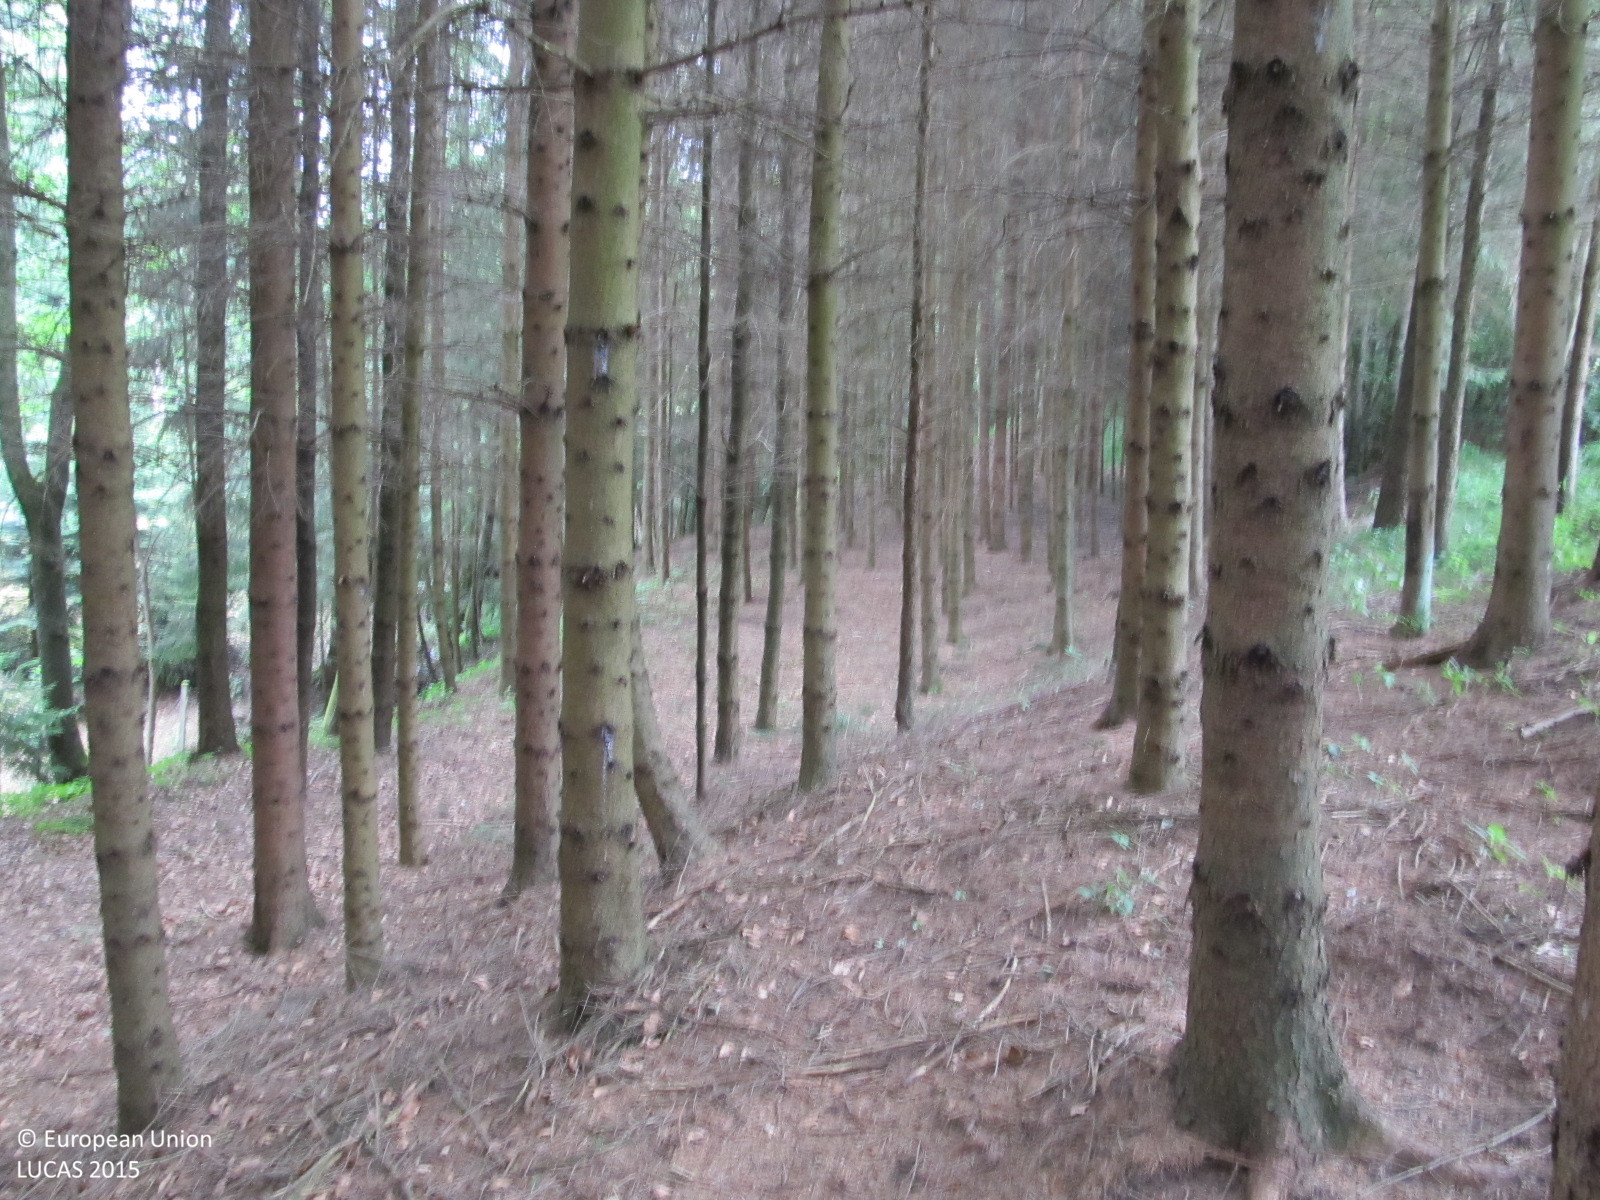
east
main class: Woodland
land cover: Spruce dominated coniferous woodland
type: hemiboreal forest and nemoral coniferous forest and mixed broadleaved-coniferous forest
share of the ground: > 75 %
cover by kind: coniferous forest trees 80 %, unconsolidated bare surface 20 %
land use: Forestry
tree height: > 5 m
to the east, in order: Spruce dominated coniferous woodland; Broadleaved woodland; Rivers and streams; Broadleaved woodland; Rivers and streams; Fences; Other coniferous woodland; Grass margins; Paved roads, cycling and walking lanes; Broadleaved woodland; Tracks; Broadleaved woodland
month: July
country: AT
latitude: 48.2687
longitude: 15.4587
